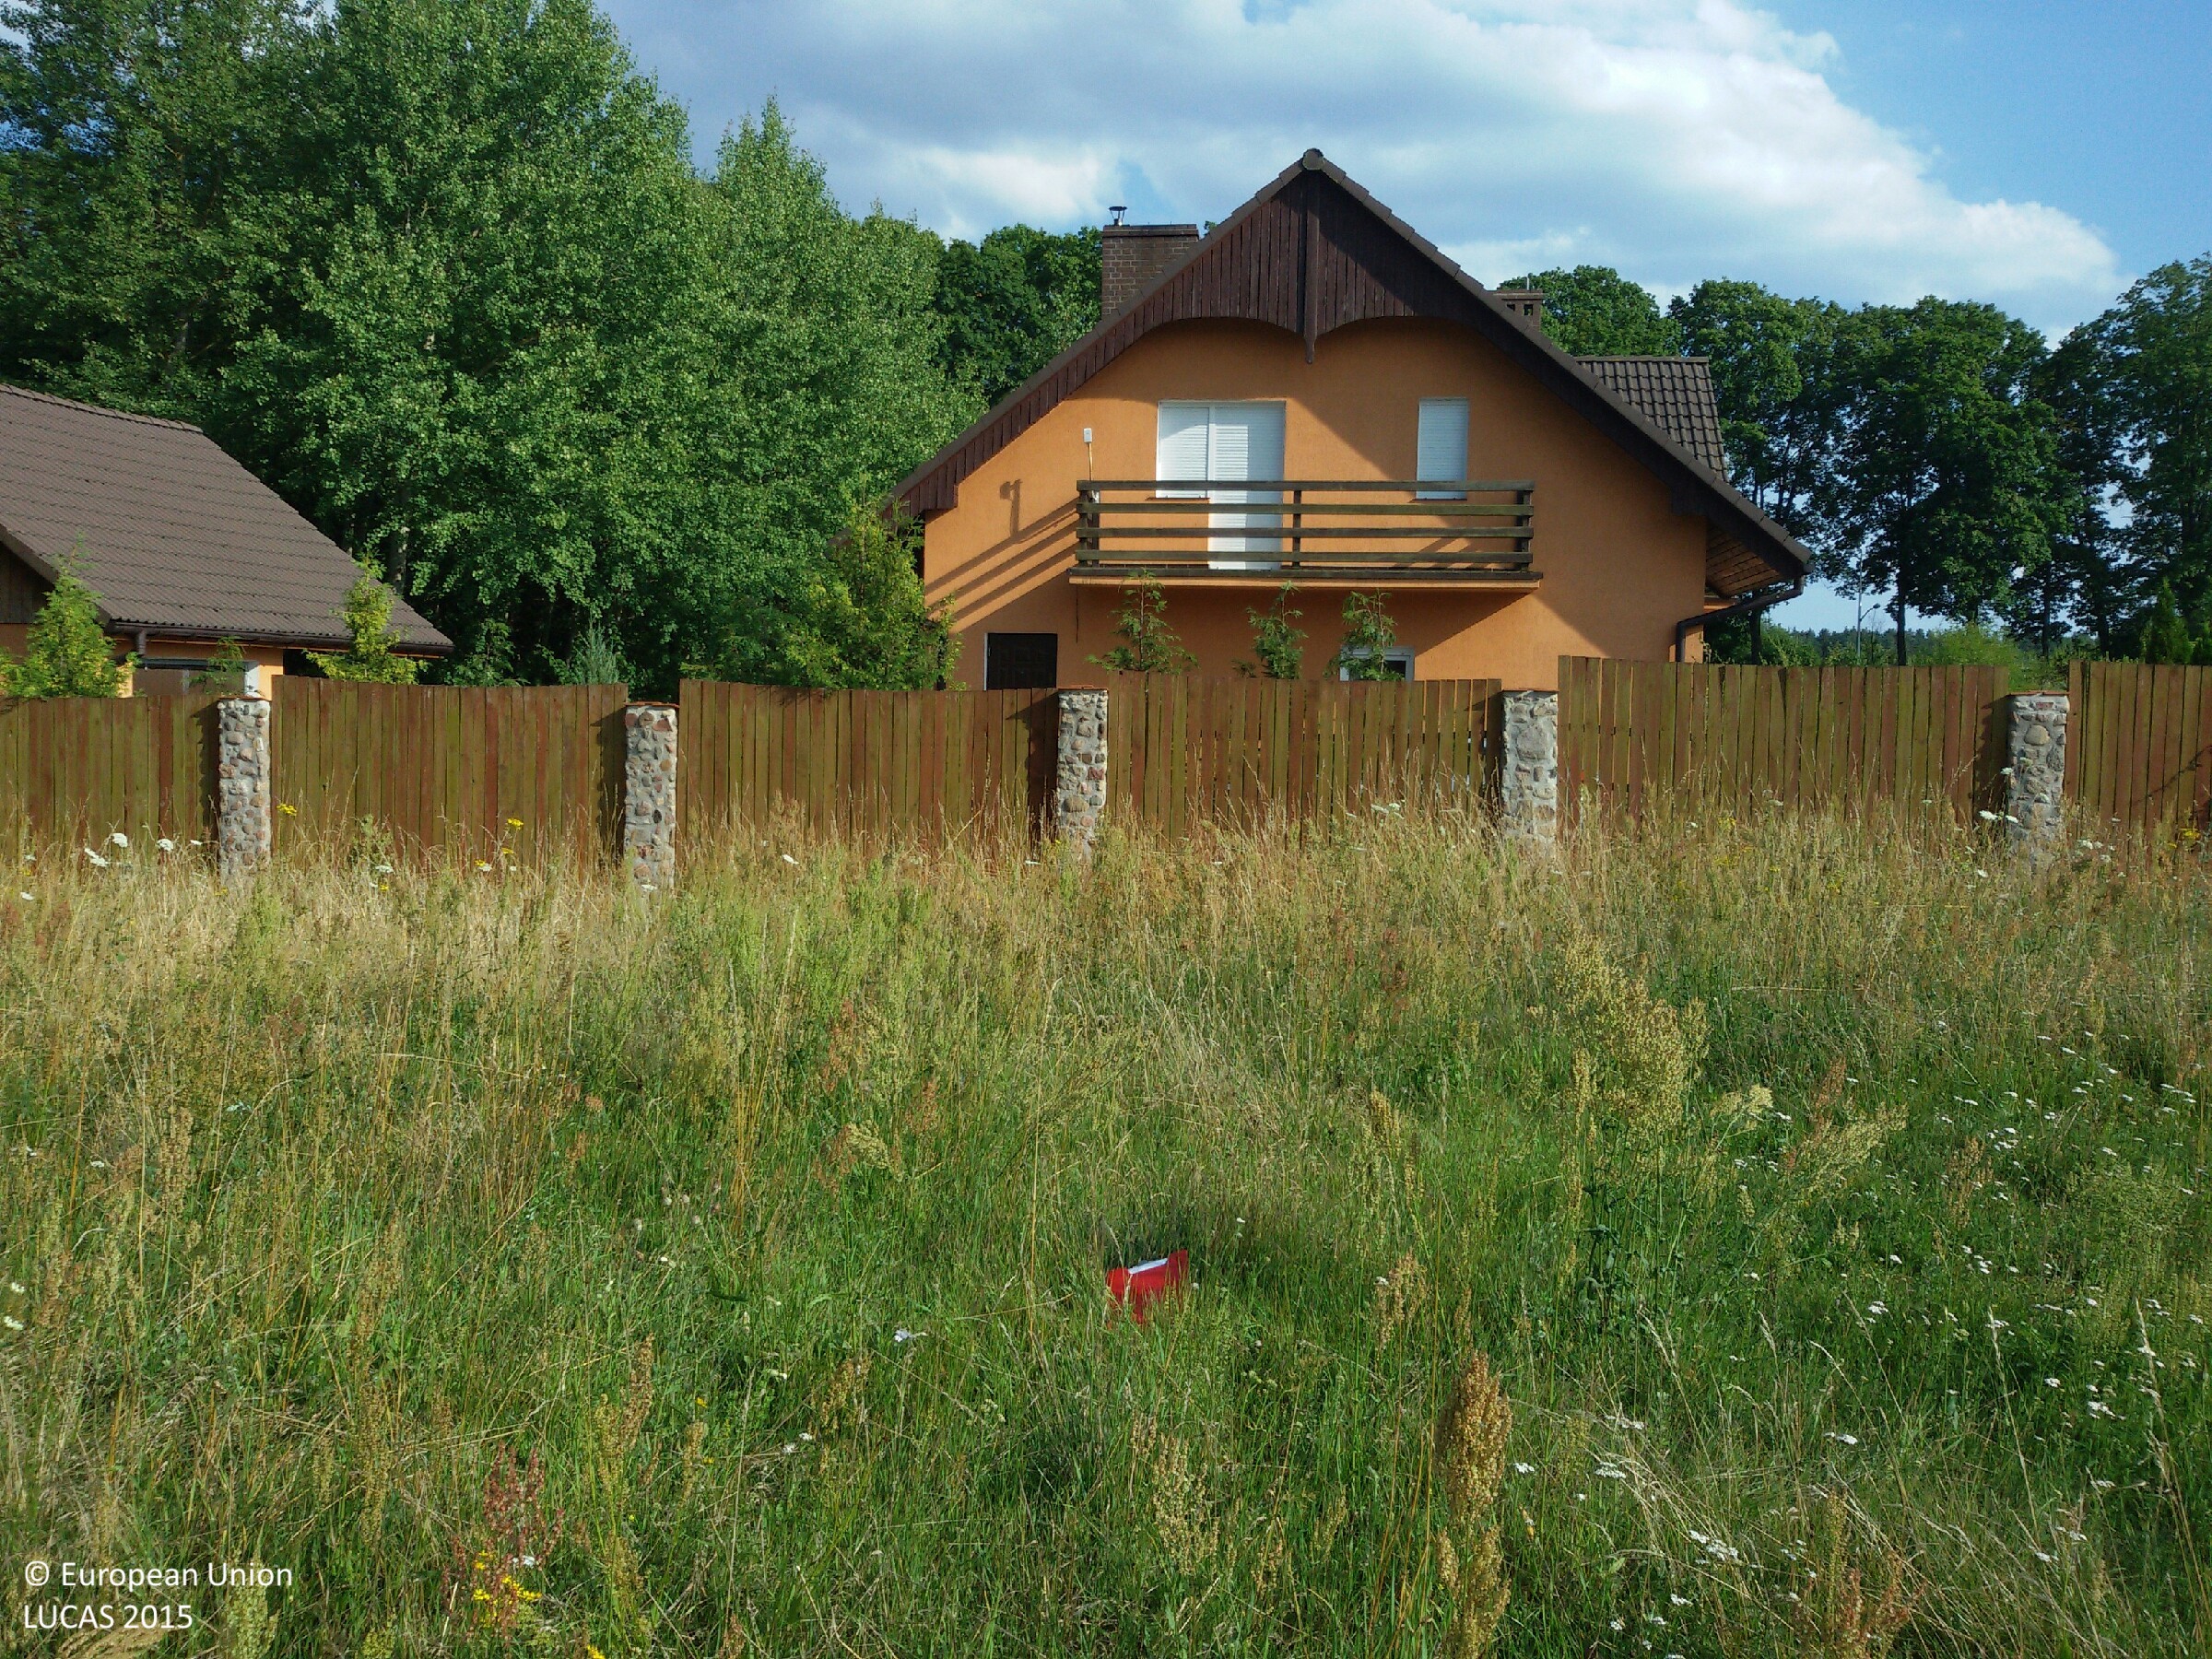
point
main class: Grassland
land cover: Spontaneously vegetated surfaces
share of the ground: > 75 %
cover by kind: herbaceous plants 100 %
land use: Construction
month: July
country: PL
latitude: 53.2118
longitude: 15.7393
